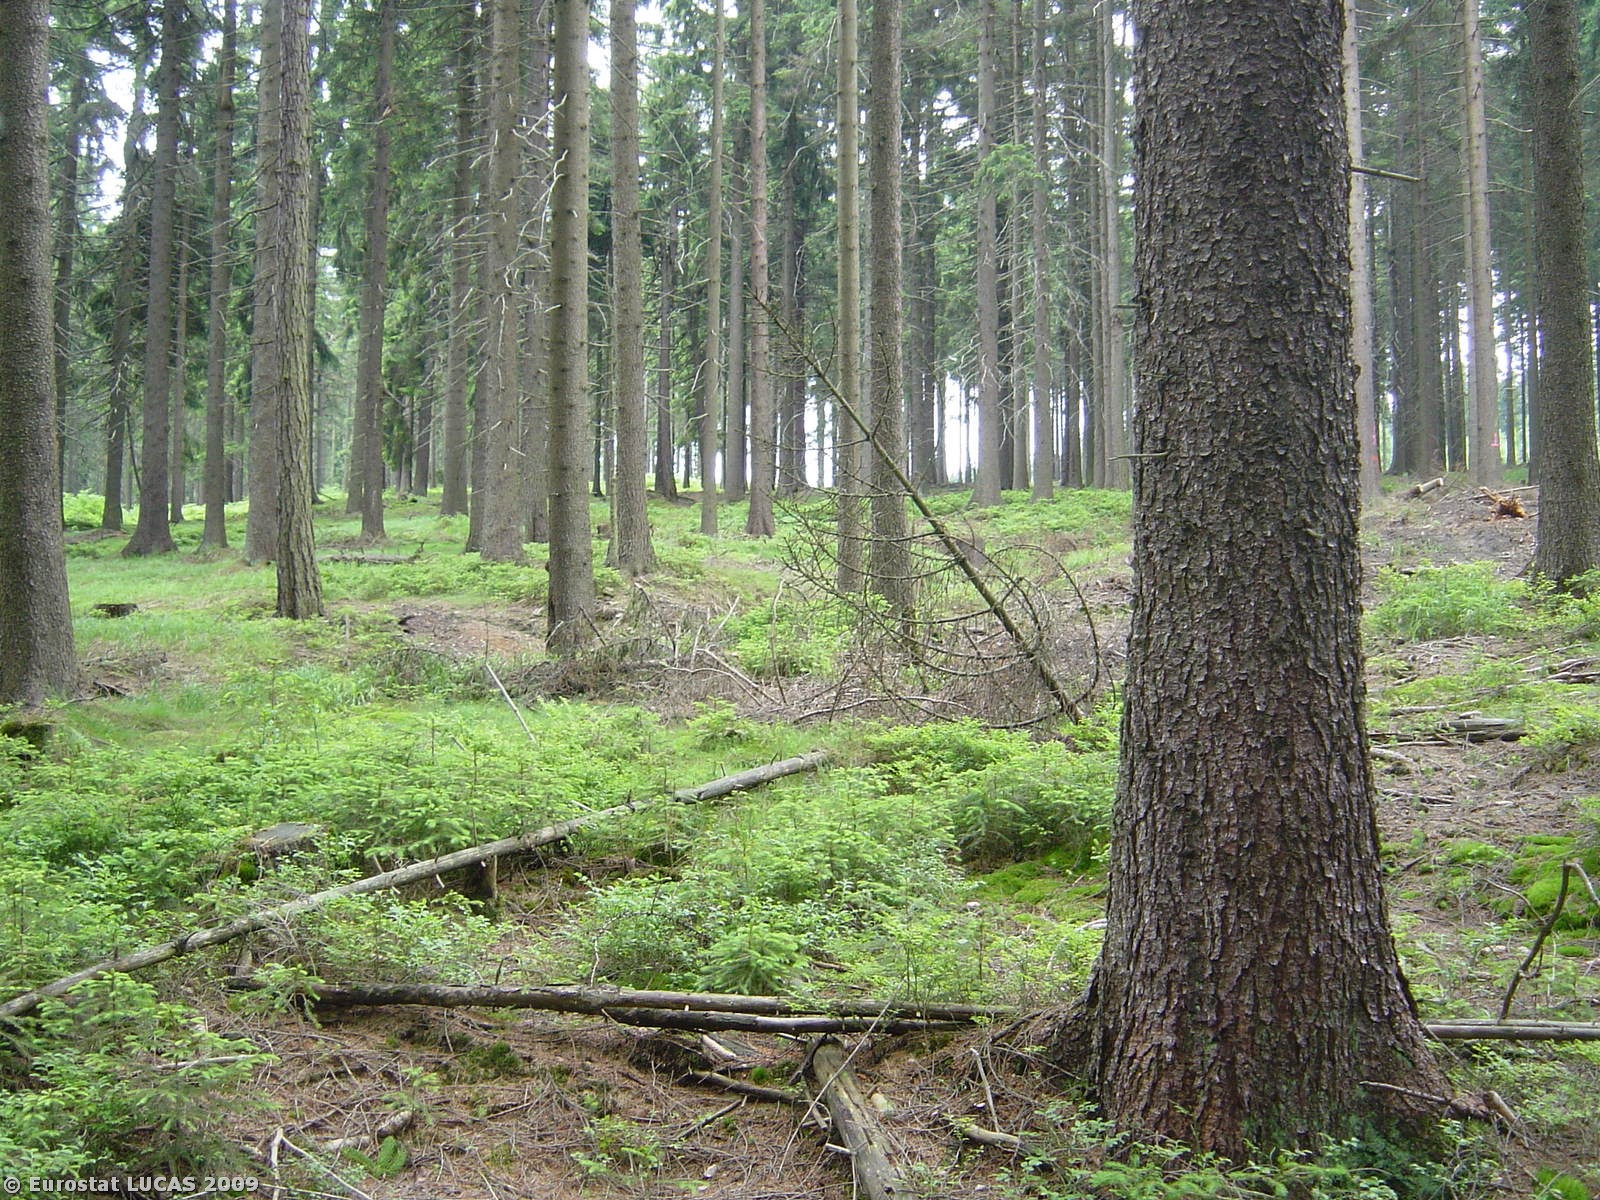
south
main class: Woodland
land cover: Coniferous woodland
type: hemiboreal forest and nemoral coniferous forest and mixed broadleaved-coniferous forest
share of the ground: > 75 %
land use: Forestry
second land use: Nature reserves
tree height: > 5 m
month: July
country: CZ
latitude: 49.9764
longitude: 12.5236
